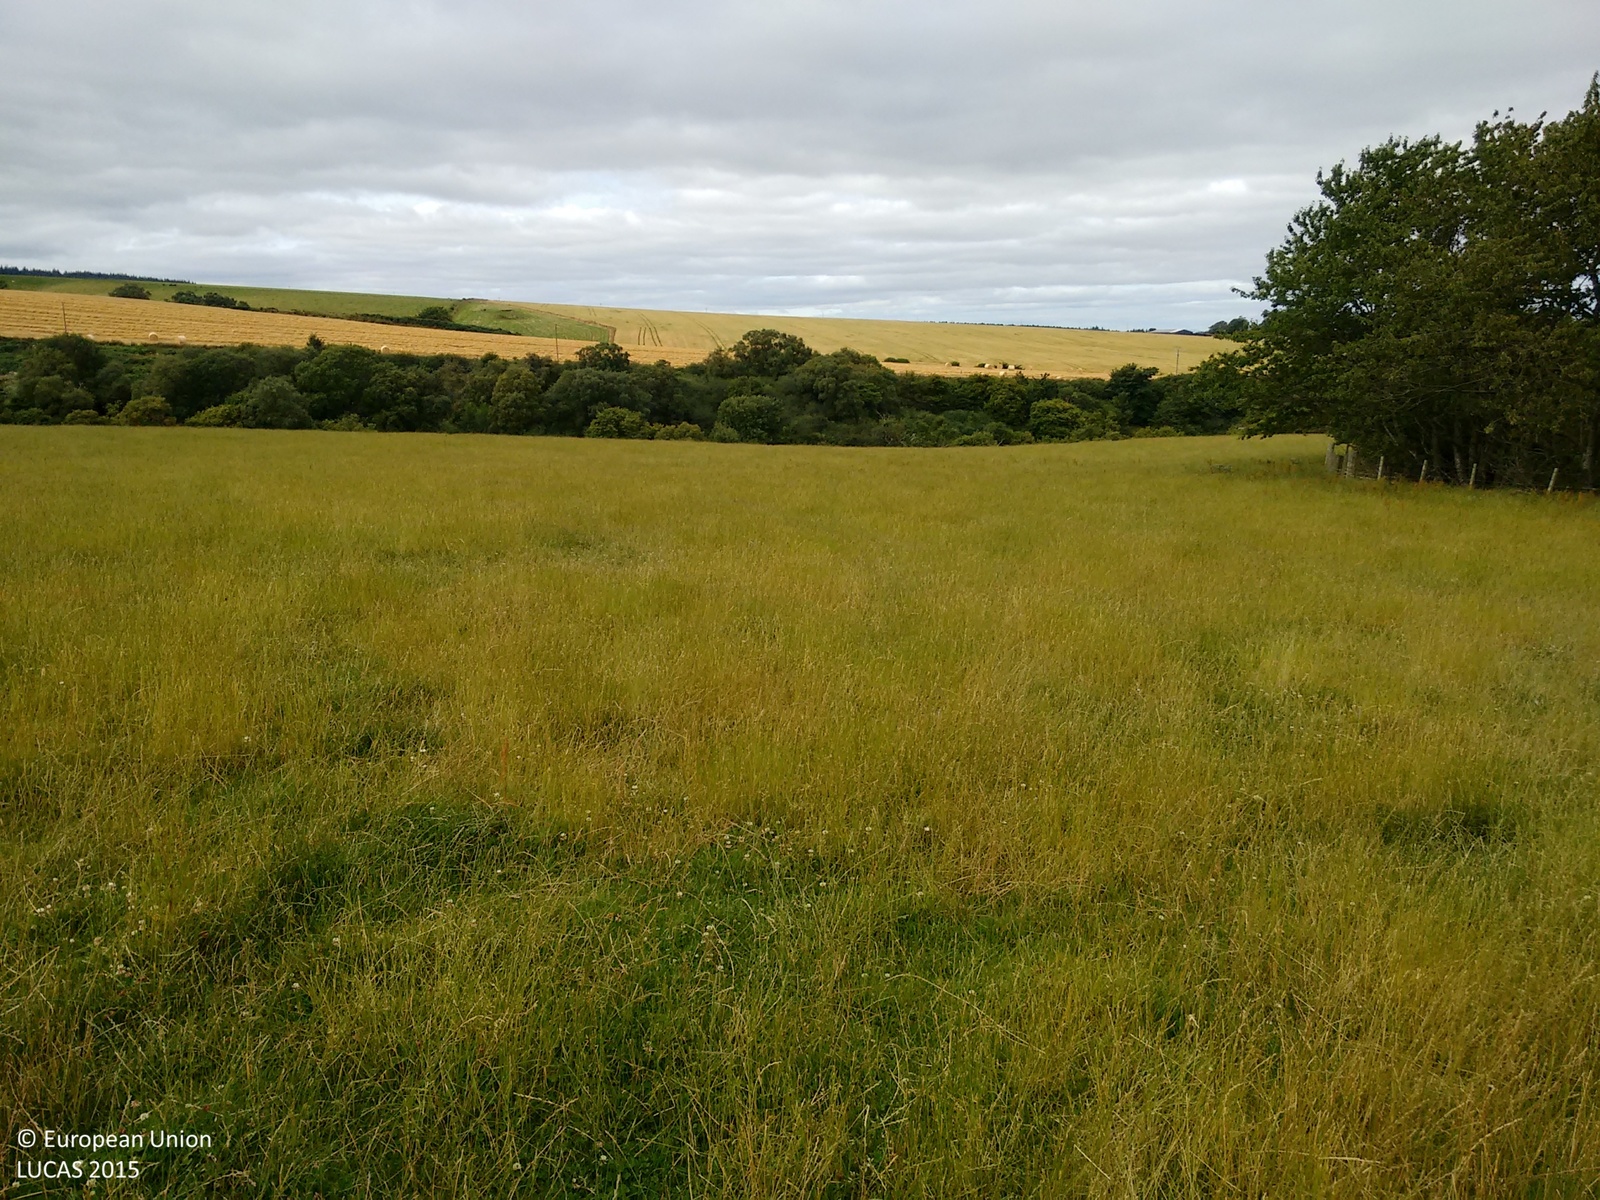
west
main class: Grassland
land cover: Grassland without tree/shrub cover
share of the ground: > 75 %
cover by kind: herbaceous plants 100 %
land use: Agriculture (excluding fallow land and kitchen gardens)
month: August
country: GB
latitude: 57.6208
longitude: -3.0026
